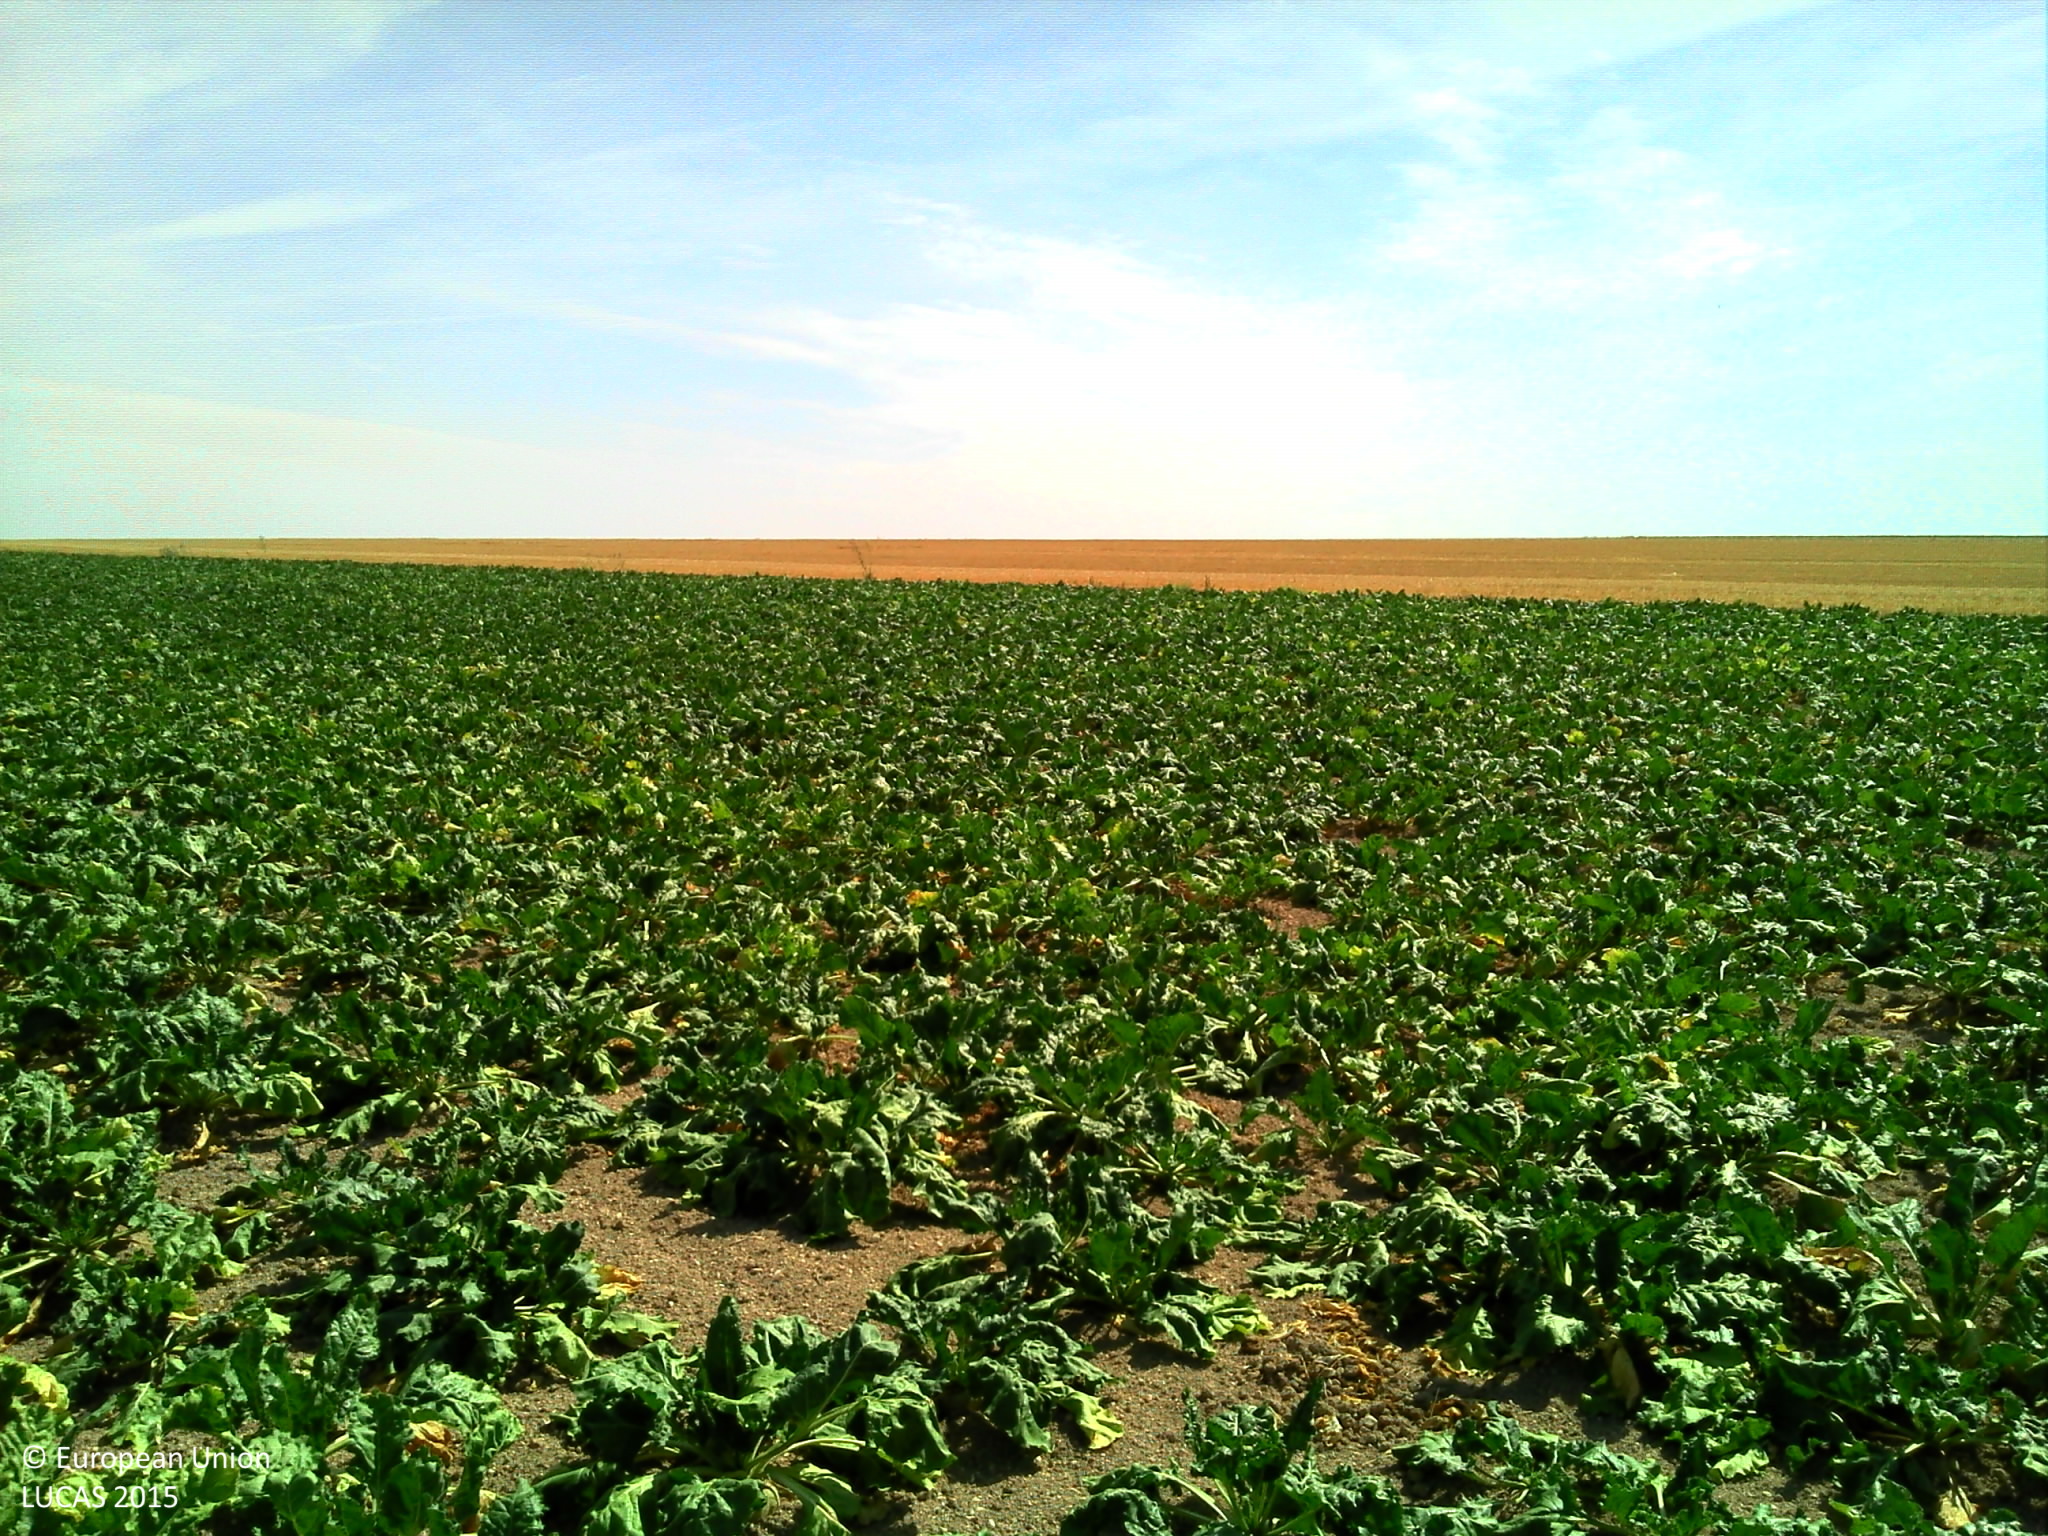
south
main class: Cropland
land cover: Sugar beet
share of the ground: > 75 %
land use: Agriculture (excluding fallow land and kitchen gardens)
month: August
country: FR
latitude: 48.9694
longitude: 4.1353
